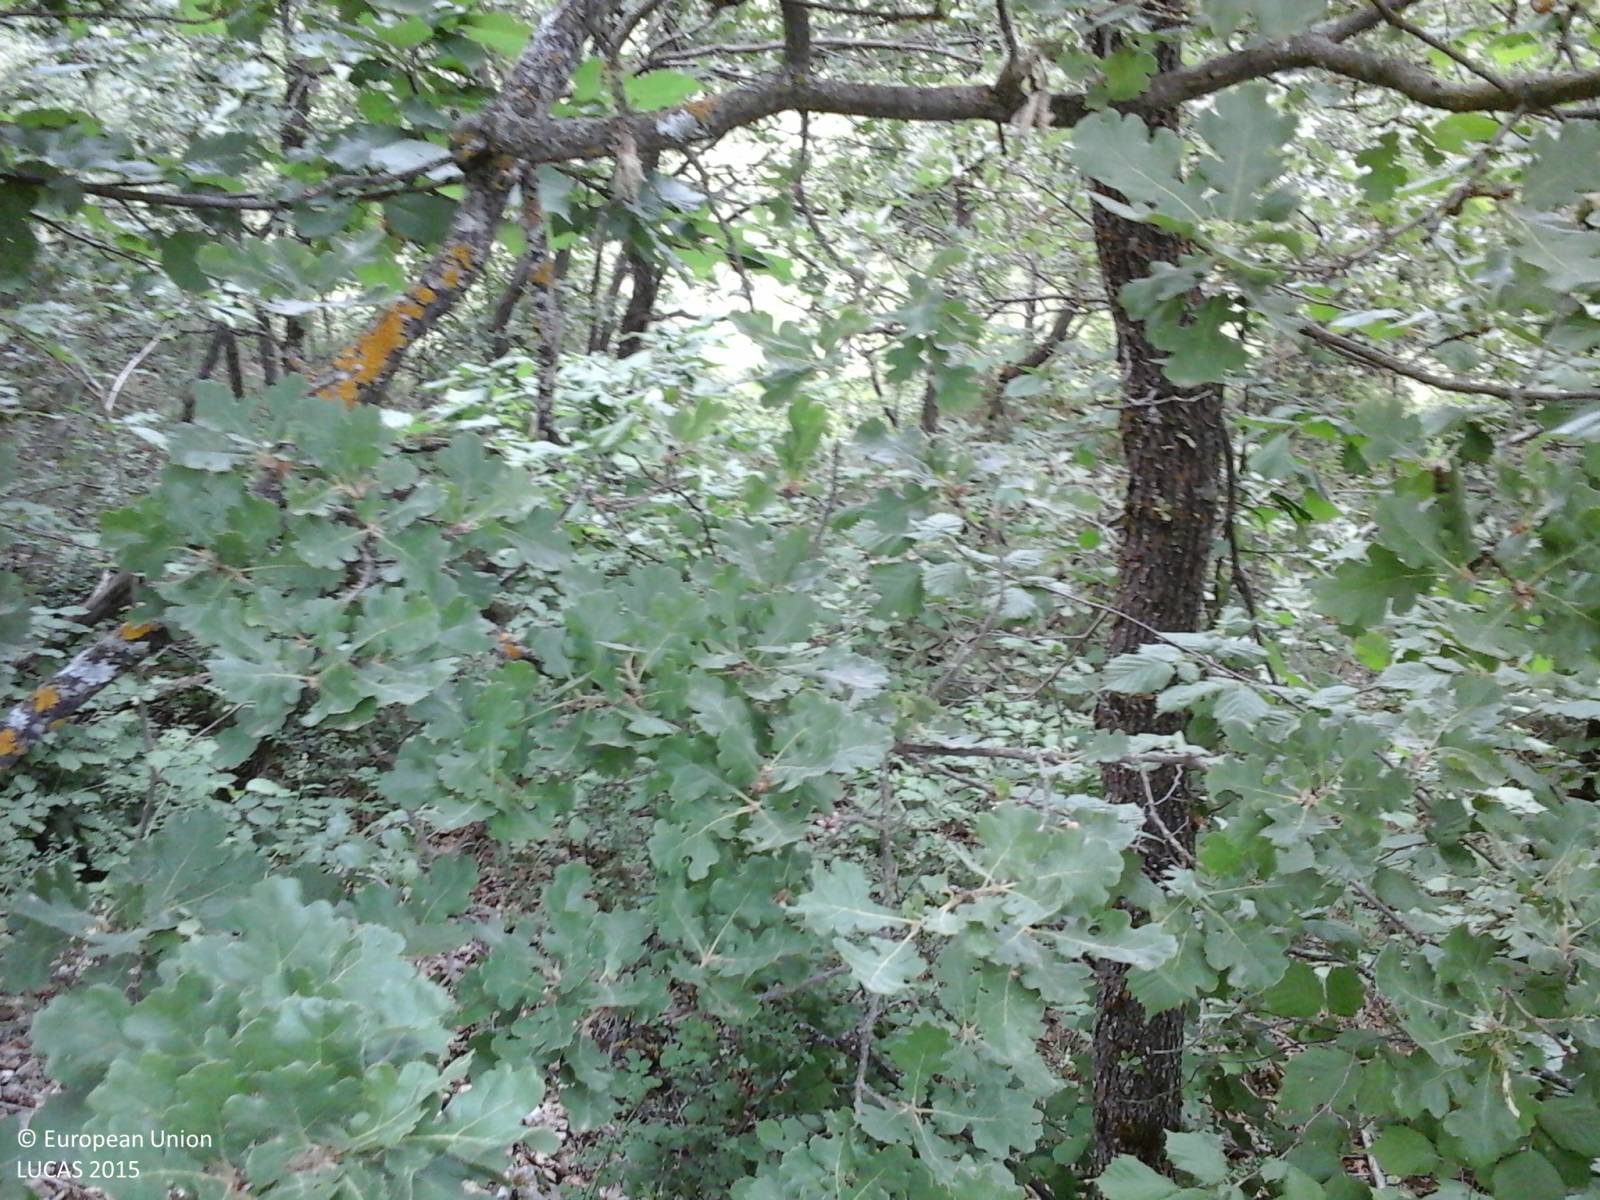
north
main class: Woodland
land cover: Broadleaved woodland
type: thermophilous deciduous forest
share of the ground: > 75 %
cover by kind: broadleaved forest trees 80 %, shrubs 20 %
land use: Semi-natural and natural areas not in use
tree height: > 5 m
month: June
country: IT
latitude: 42.0793
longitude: 13.7227
